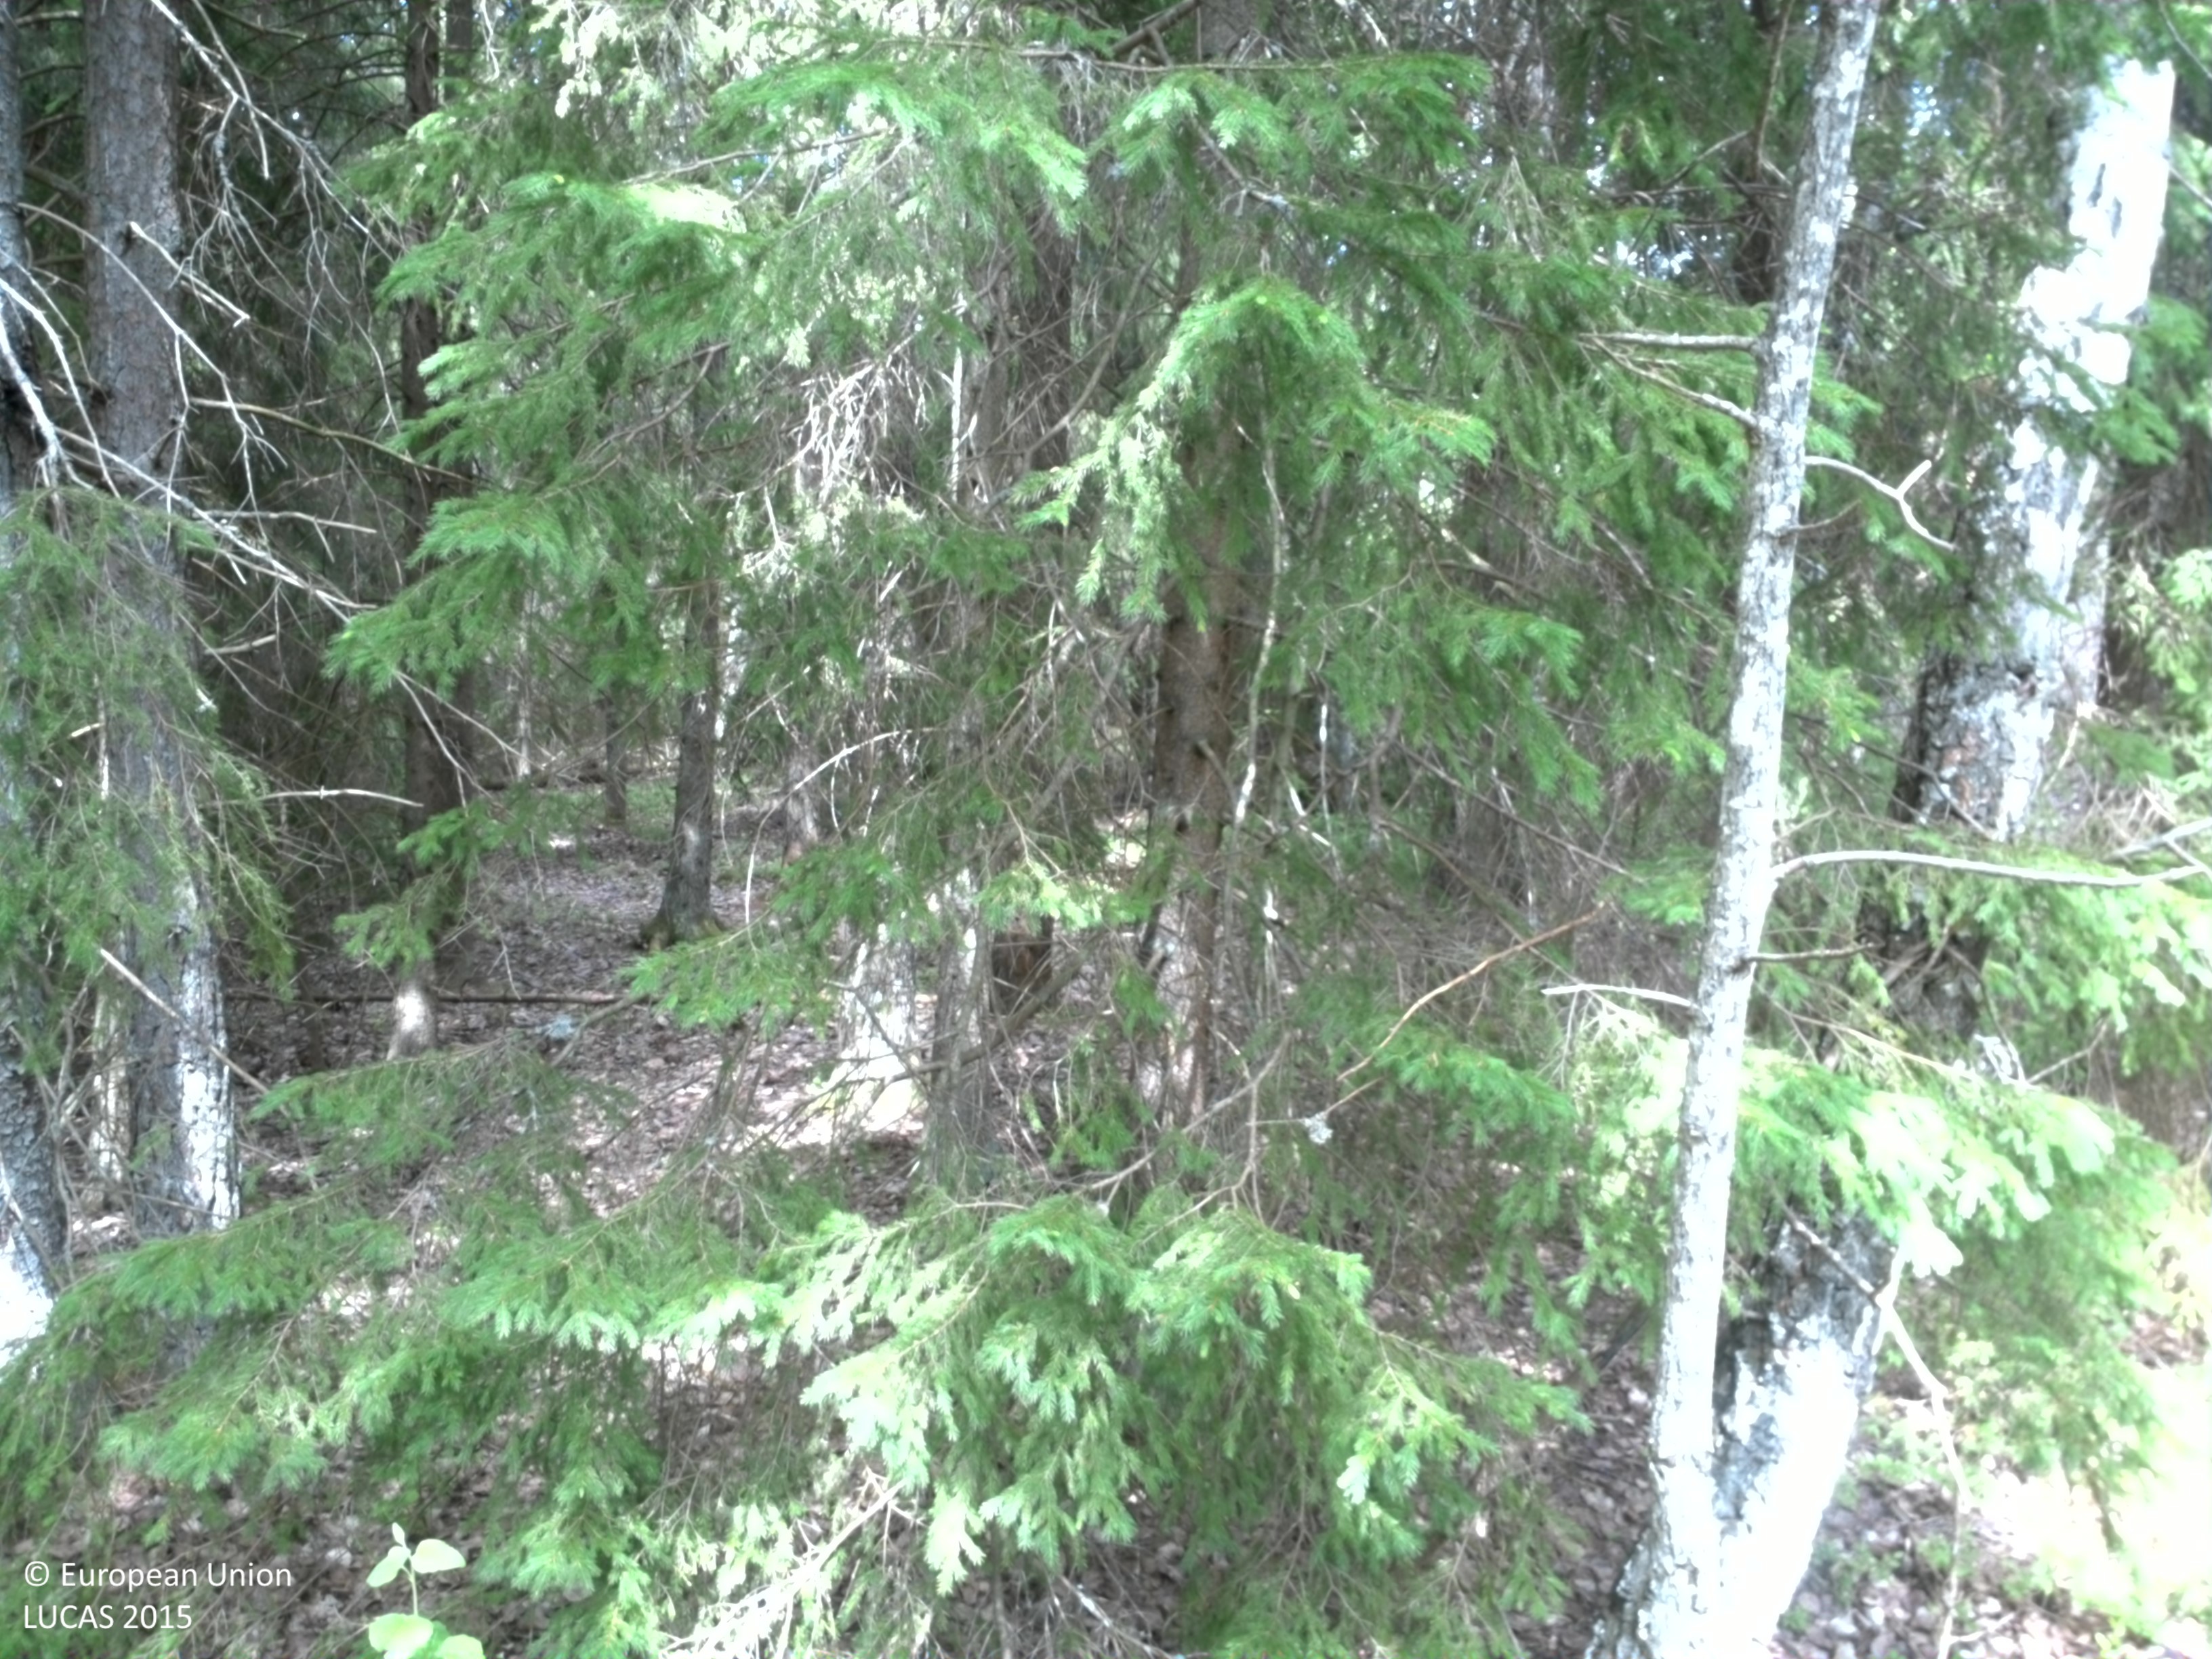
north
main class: Woodland
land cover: Broadleaved woodland
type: hemiboreal forest and nemoral coniferous forest and mixed broadleaved-coniferous forest
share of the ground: 25 - 50 %
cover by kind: broadleaved forest trees 35 %, lichens and mosses 30 %, herbaceous plants 25 %, coniferous forest trees 5 %, shrubs 5 %
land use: Semi-natural and natural areas not in use
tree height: > 5 m
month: June
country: SE
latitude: 58.6744
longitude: 15.7365
